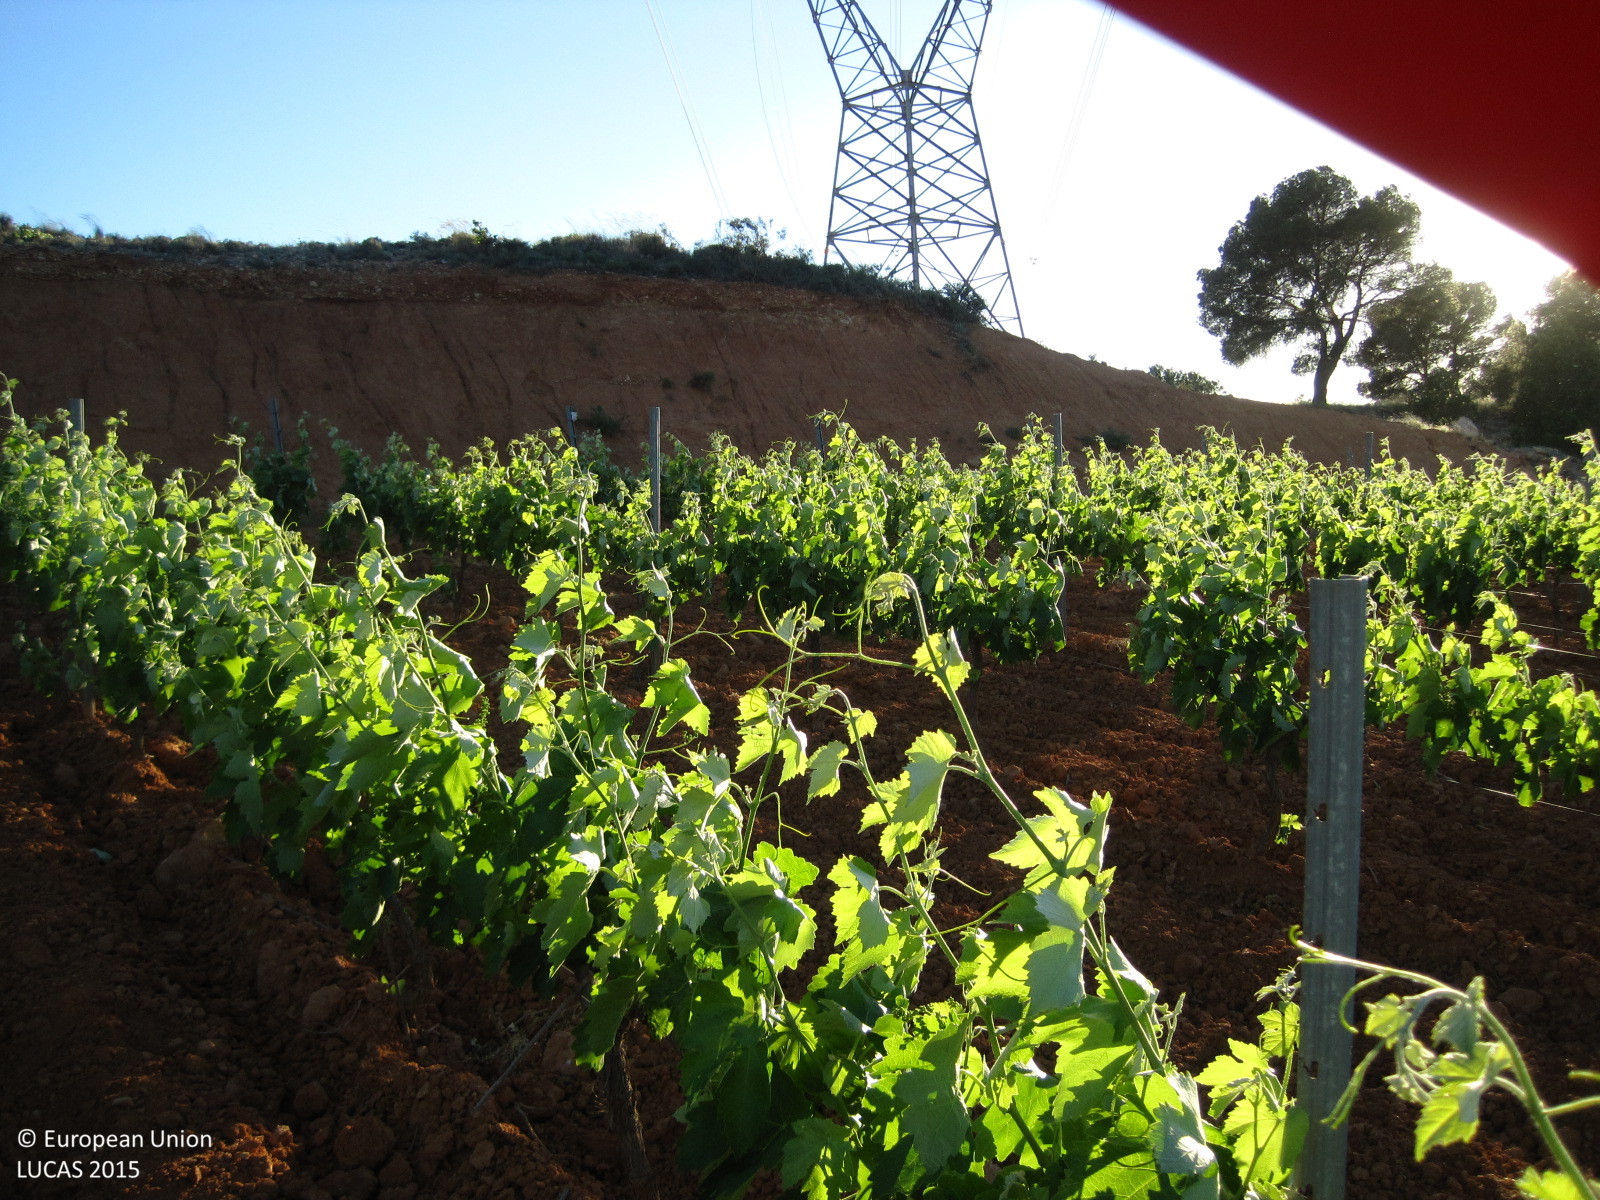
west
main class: Artificial land
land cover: Other artificial areas
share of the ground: > 75 %
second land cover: Vineyards
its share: 25 - 50 %
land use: Electricity, gas and thermal power distribution
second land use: Agriculture (excluding fallow land and kitchen gardens)
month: May
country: ES
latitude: 39.4709
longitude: -1.1021
